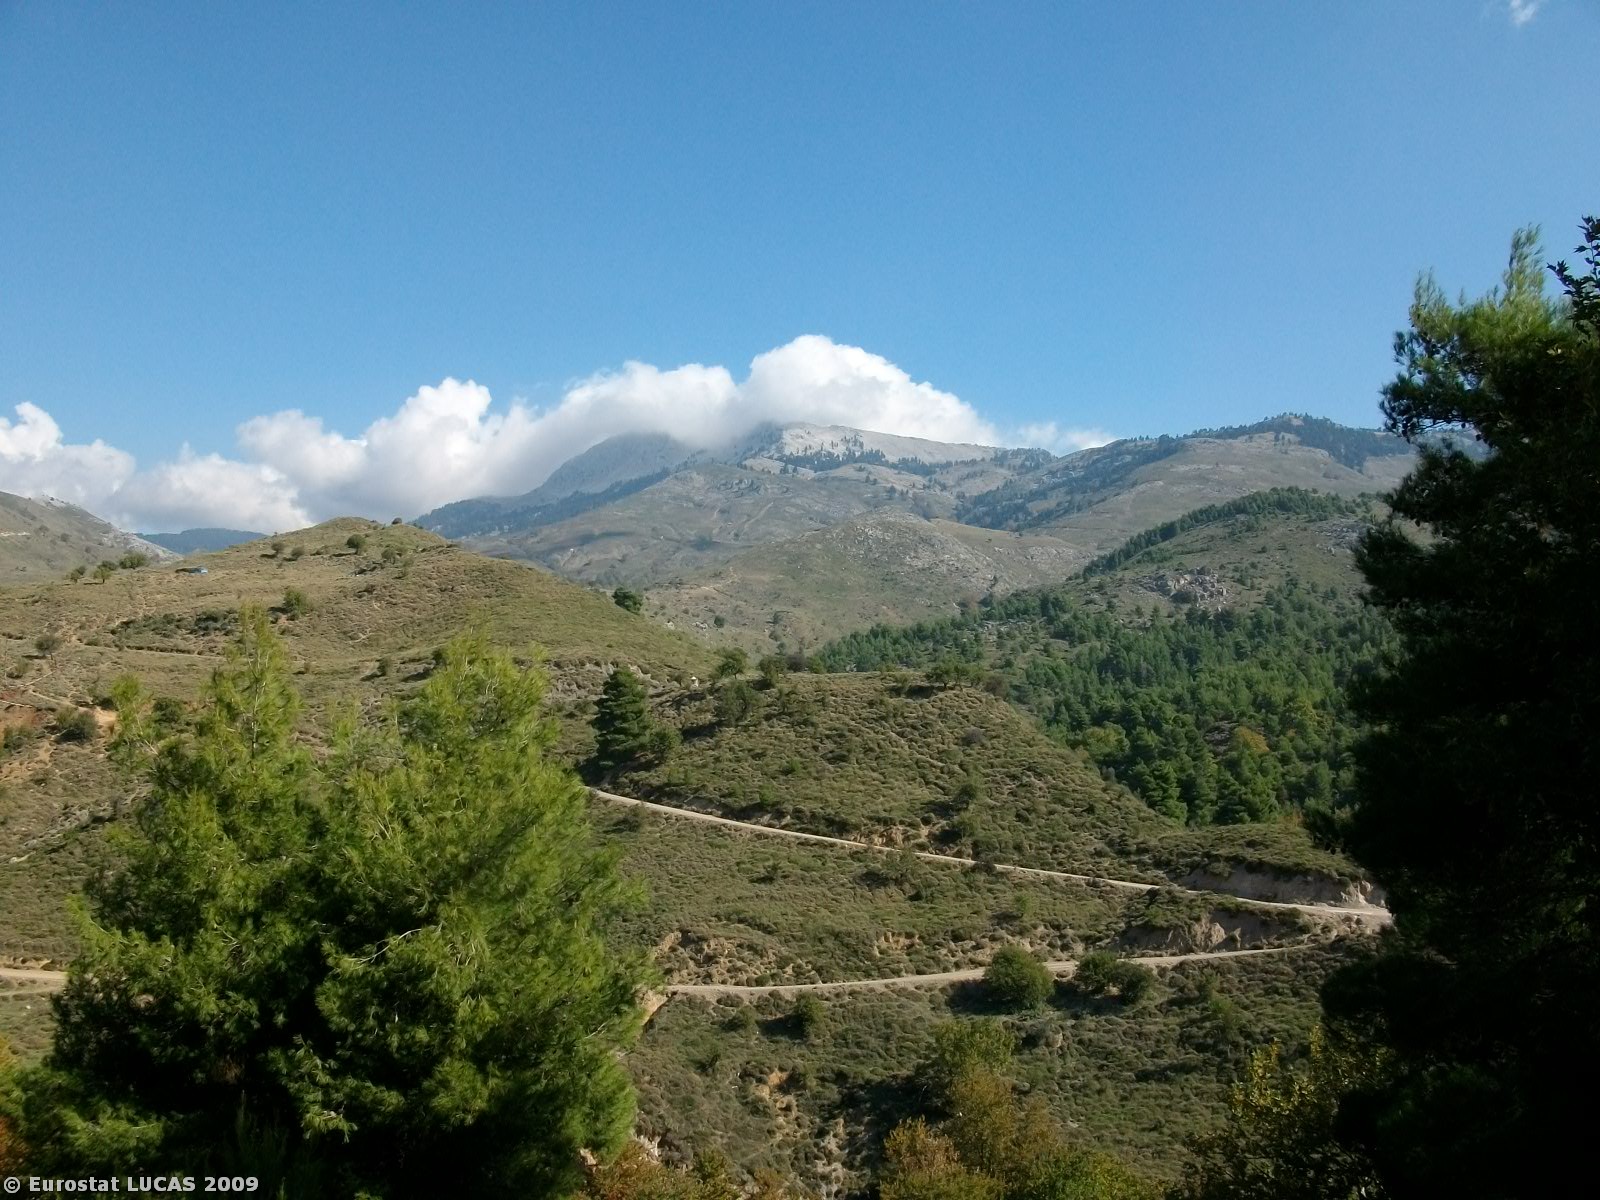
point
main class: Shrubland
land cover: Shrubland with sparse tree cover
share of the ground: > 75 %
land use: Unused
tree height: < 5 m
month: October
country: GR
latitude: 38.5446
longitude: 23.8617
